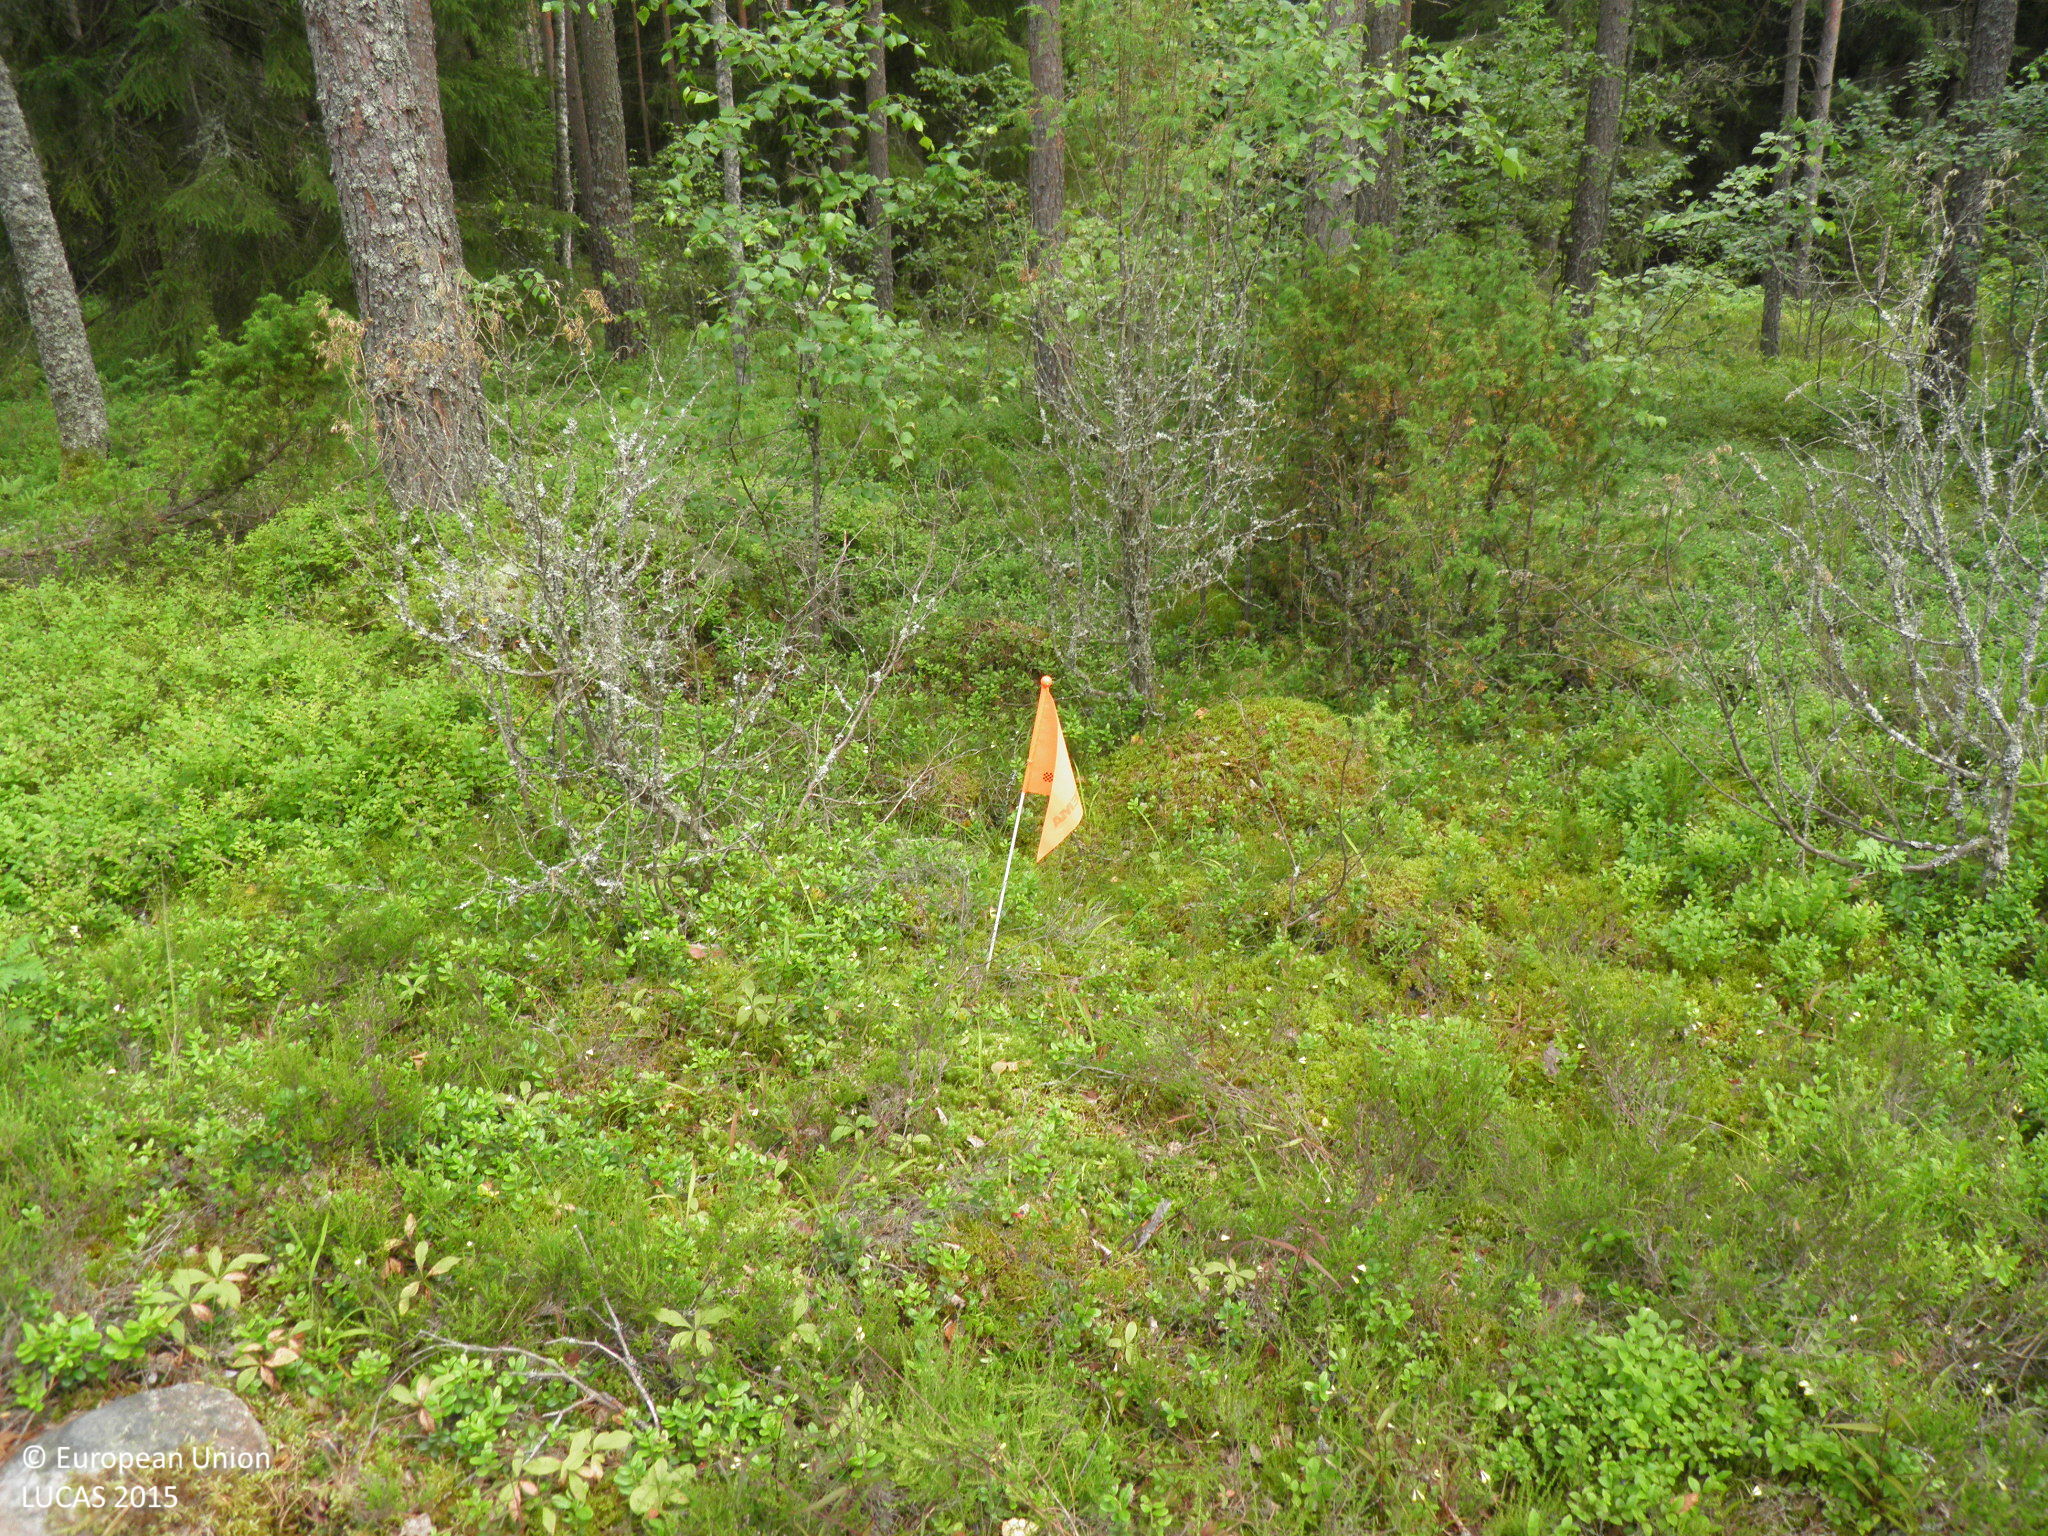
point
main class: Woodland
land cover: Pine dominated coniferous woodland
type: hemiboreal forest and nemoral coniferous forest and mixed broadleaved-coniferous forest
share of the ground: 25 - 50 %
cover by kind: shrubs 50 %, coniferous forest trees 25 %, herbaceous plants 20 %, broadleaved forest trees 5 %
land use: Forestry
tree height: > 5 m
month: July
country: FI
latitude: 60.0487
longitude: 22.6266
